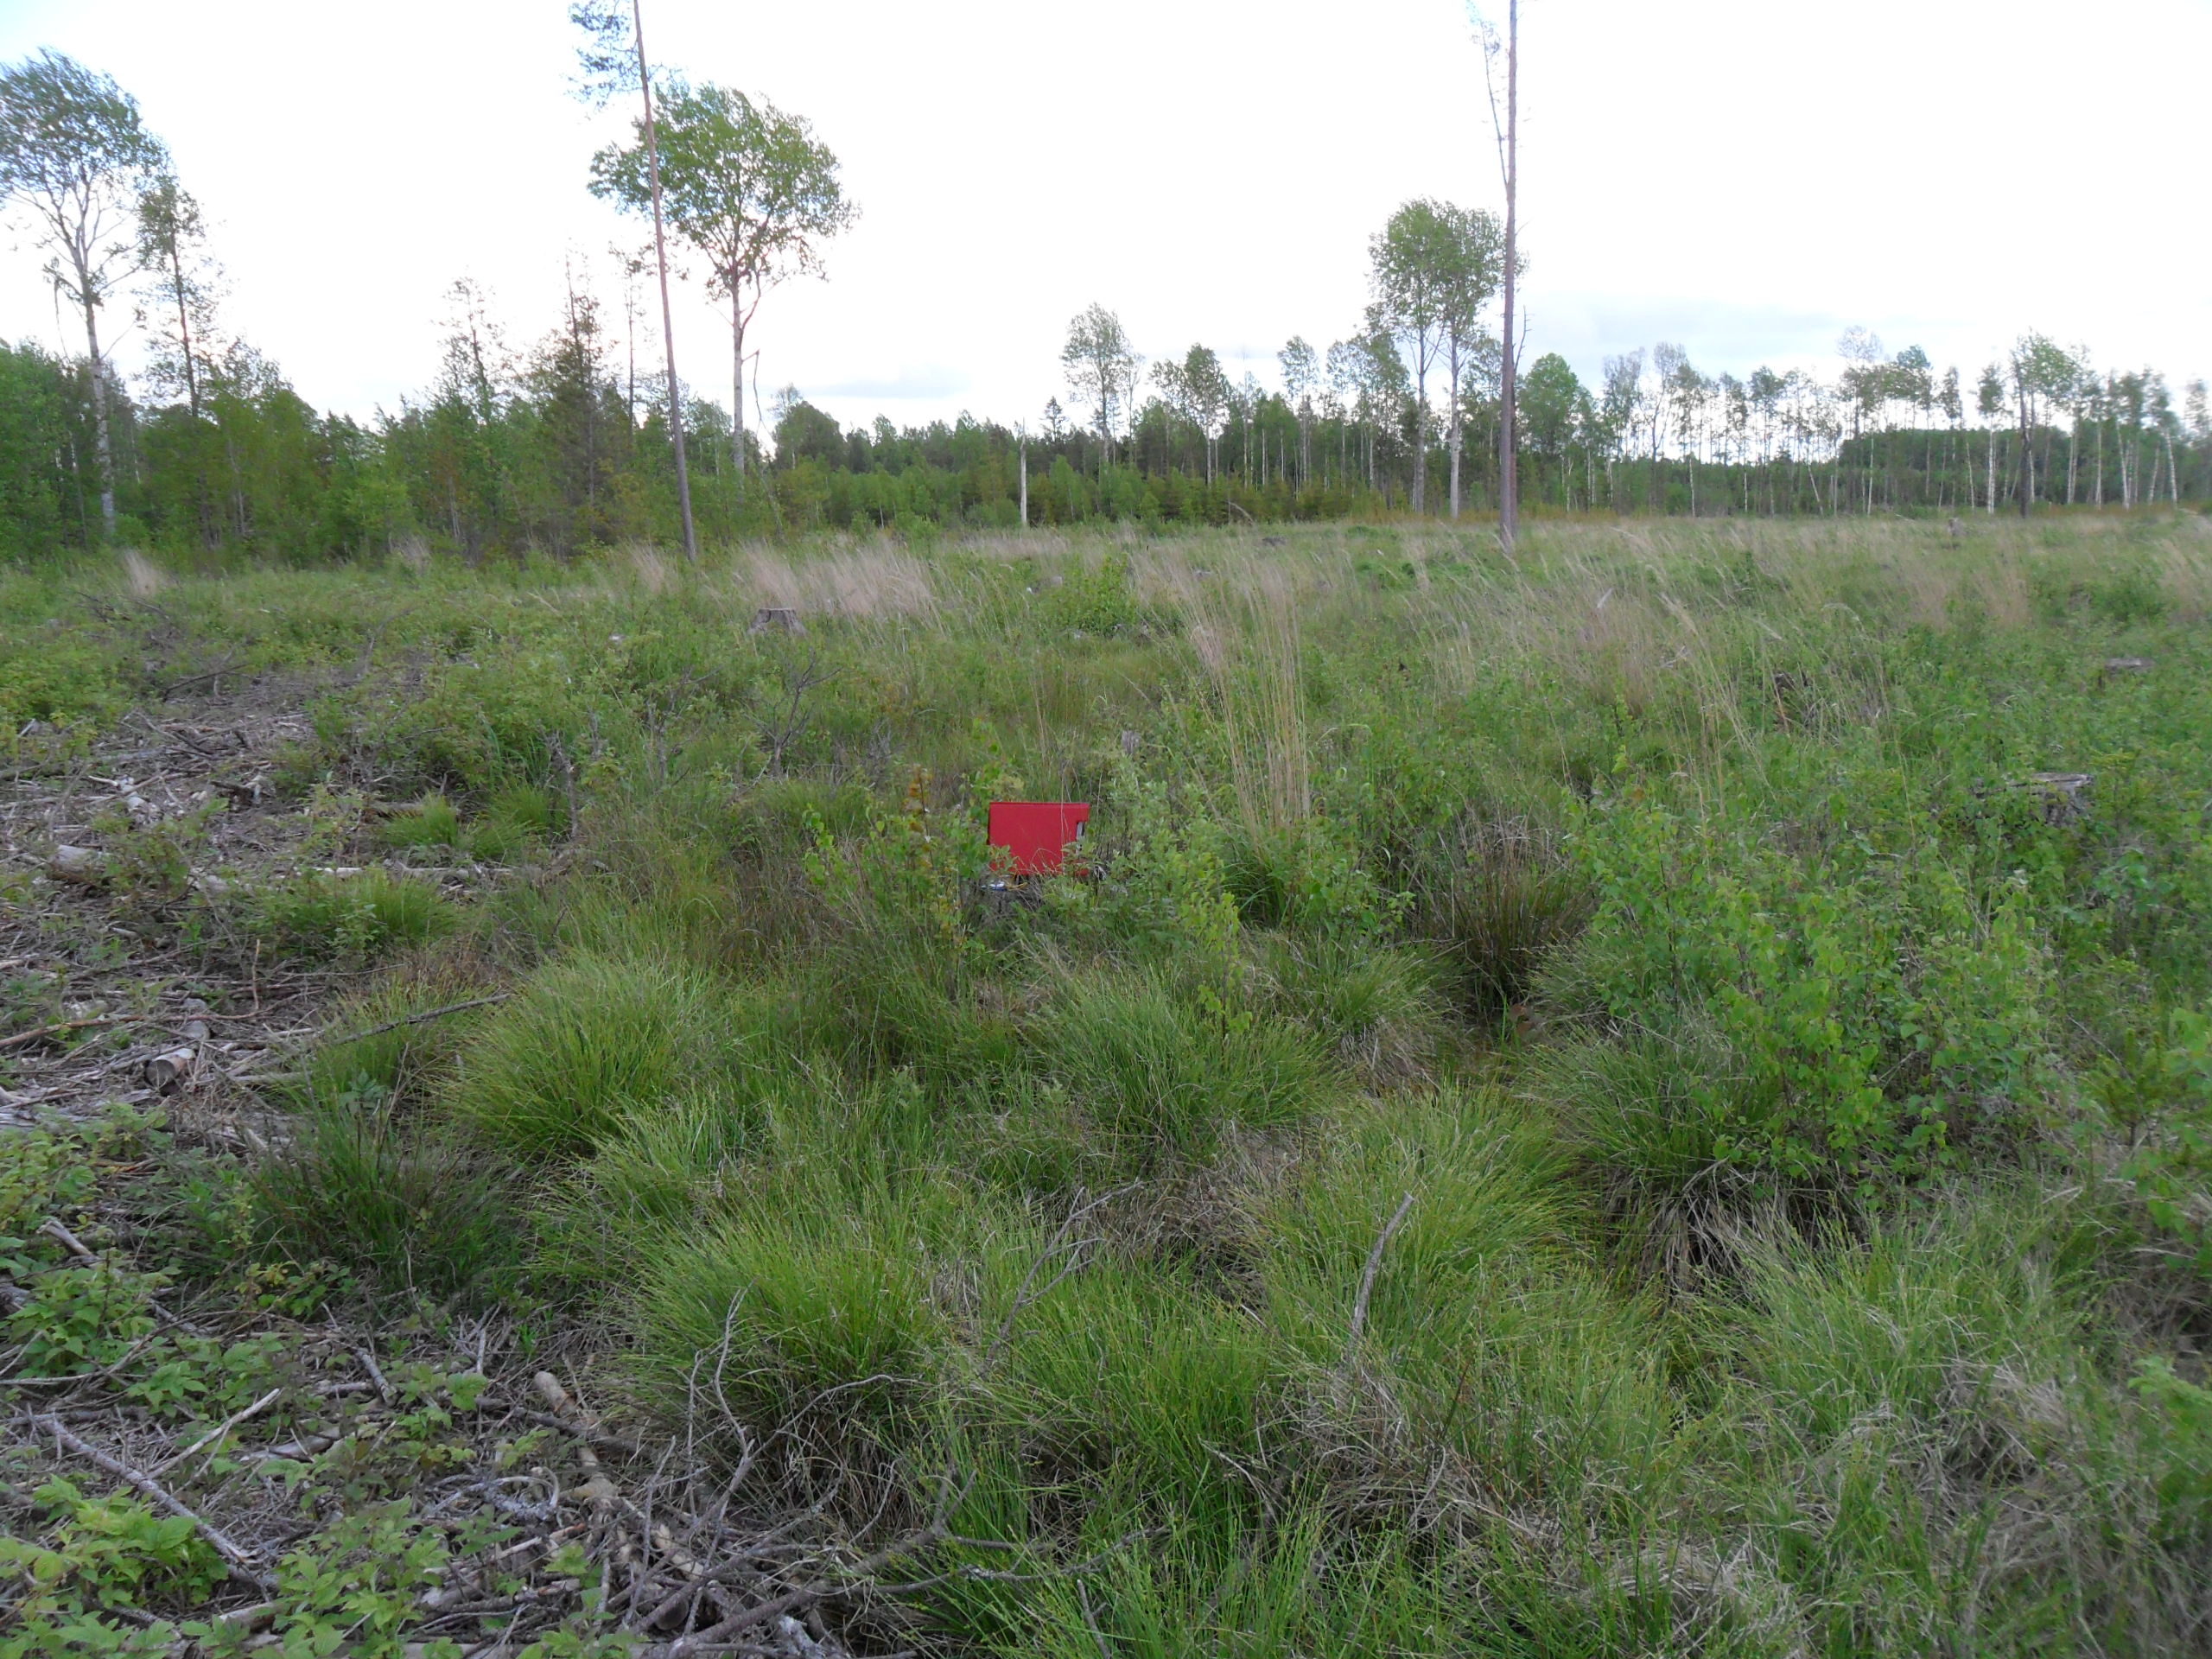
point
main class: Grassland
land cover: Grassland with sparse tree/shrub cover
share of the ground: > 75 %
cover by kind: herbaceous plants 85 %, shrubs 10 %, broadleaved forest trees 5 %
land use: Forestry
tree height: < 5 m
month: June
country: LV
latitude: 57.3093
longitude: 22.4536
